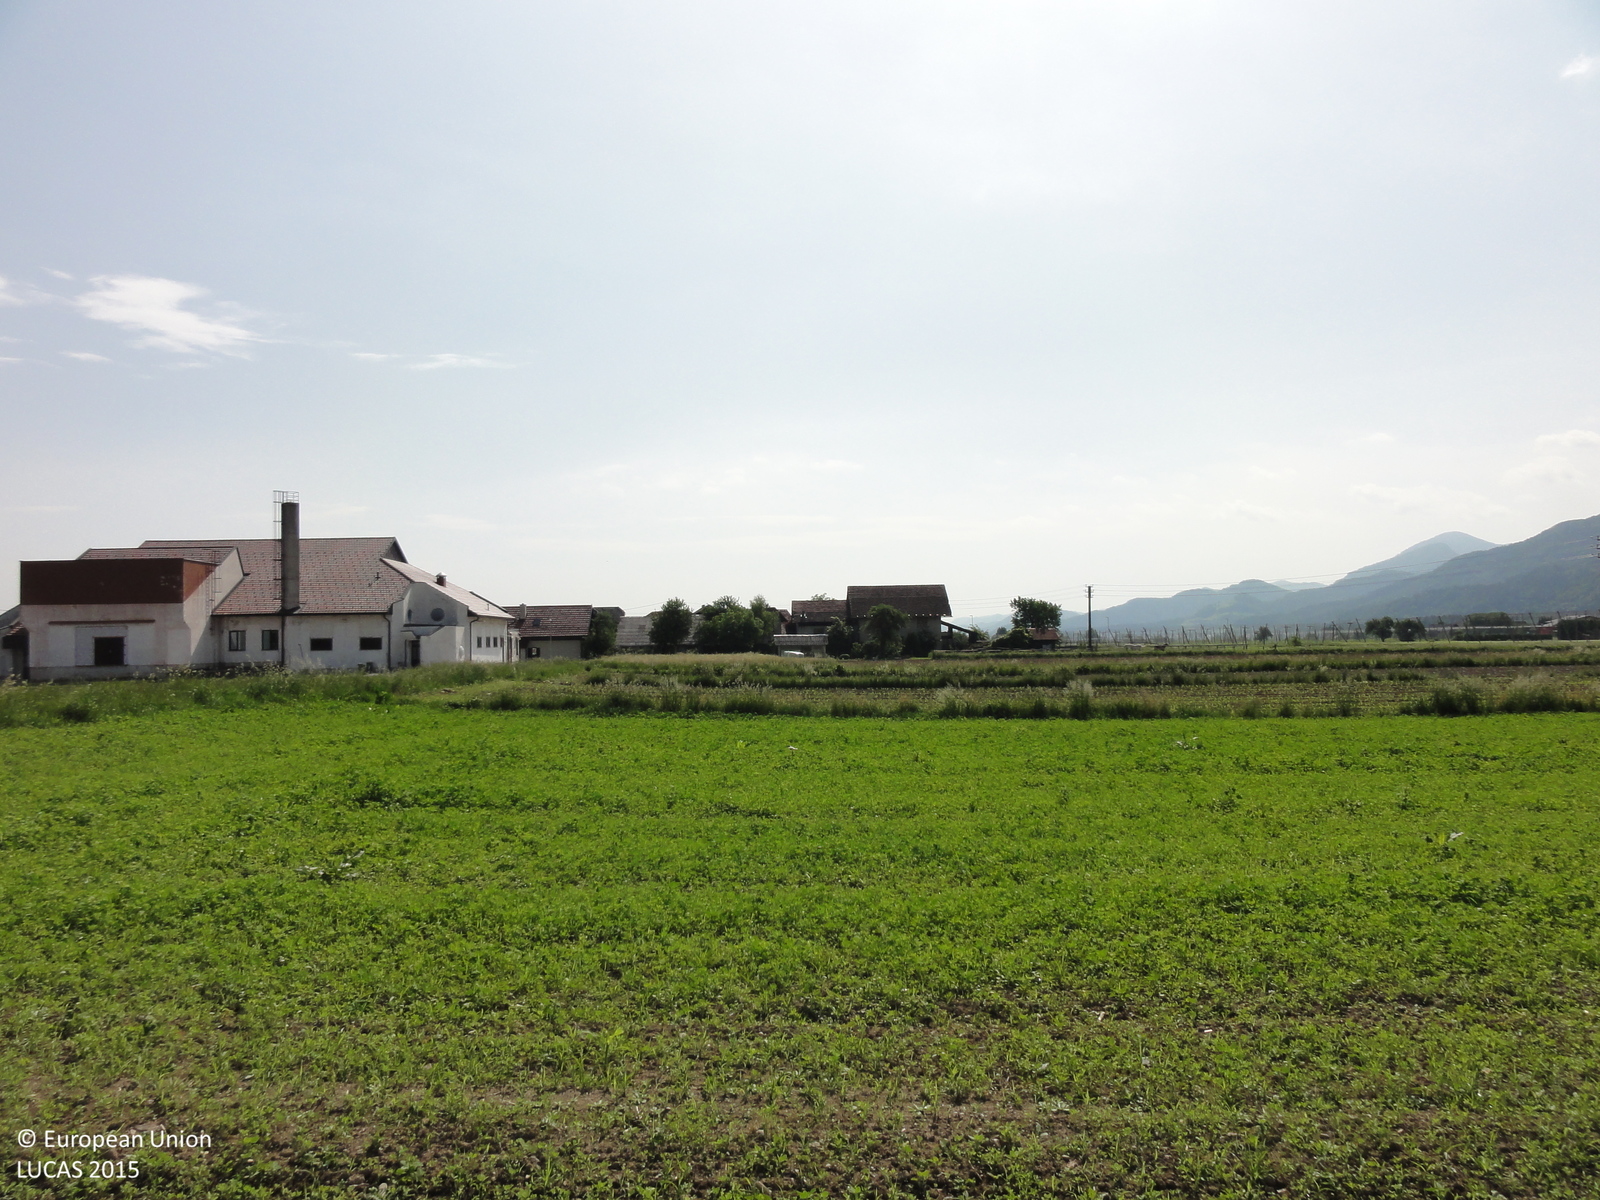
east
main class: Cropland
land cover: Maize
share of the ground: > 75 %
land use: Agriculture (excluding fallow land and kitchen gardens)
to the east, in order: Maize; Grass margins; Other leguminous and mixtures for fodder; Grass margins; Maize; Grass margins; Maize; Grass margins; Maize; Grassland without tree/shrub cover; Artificial constructions in urban areas
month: May
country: SI
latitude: 46.2503
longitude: 15.0432
